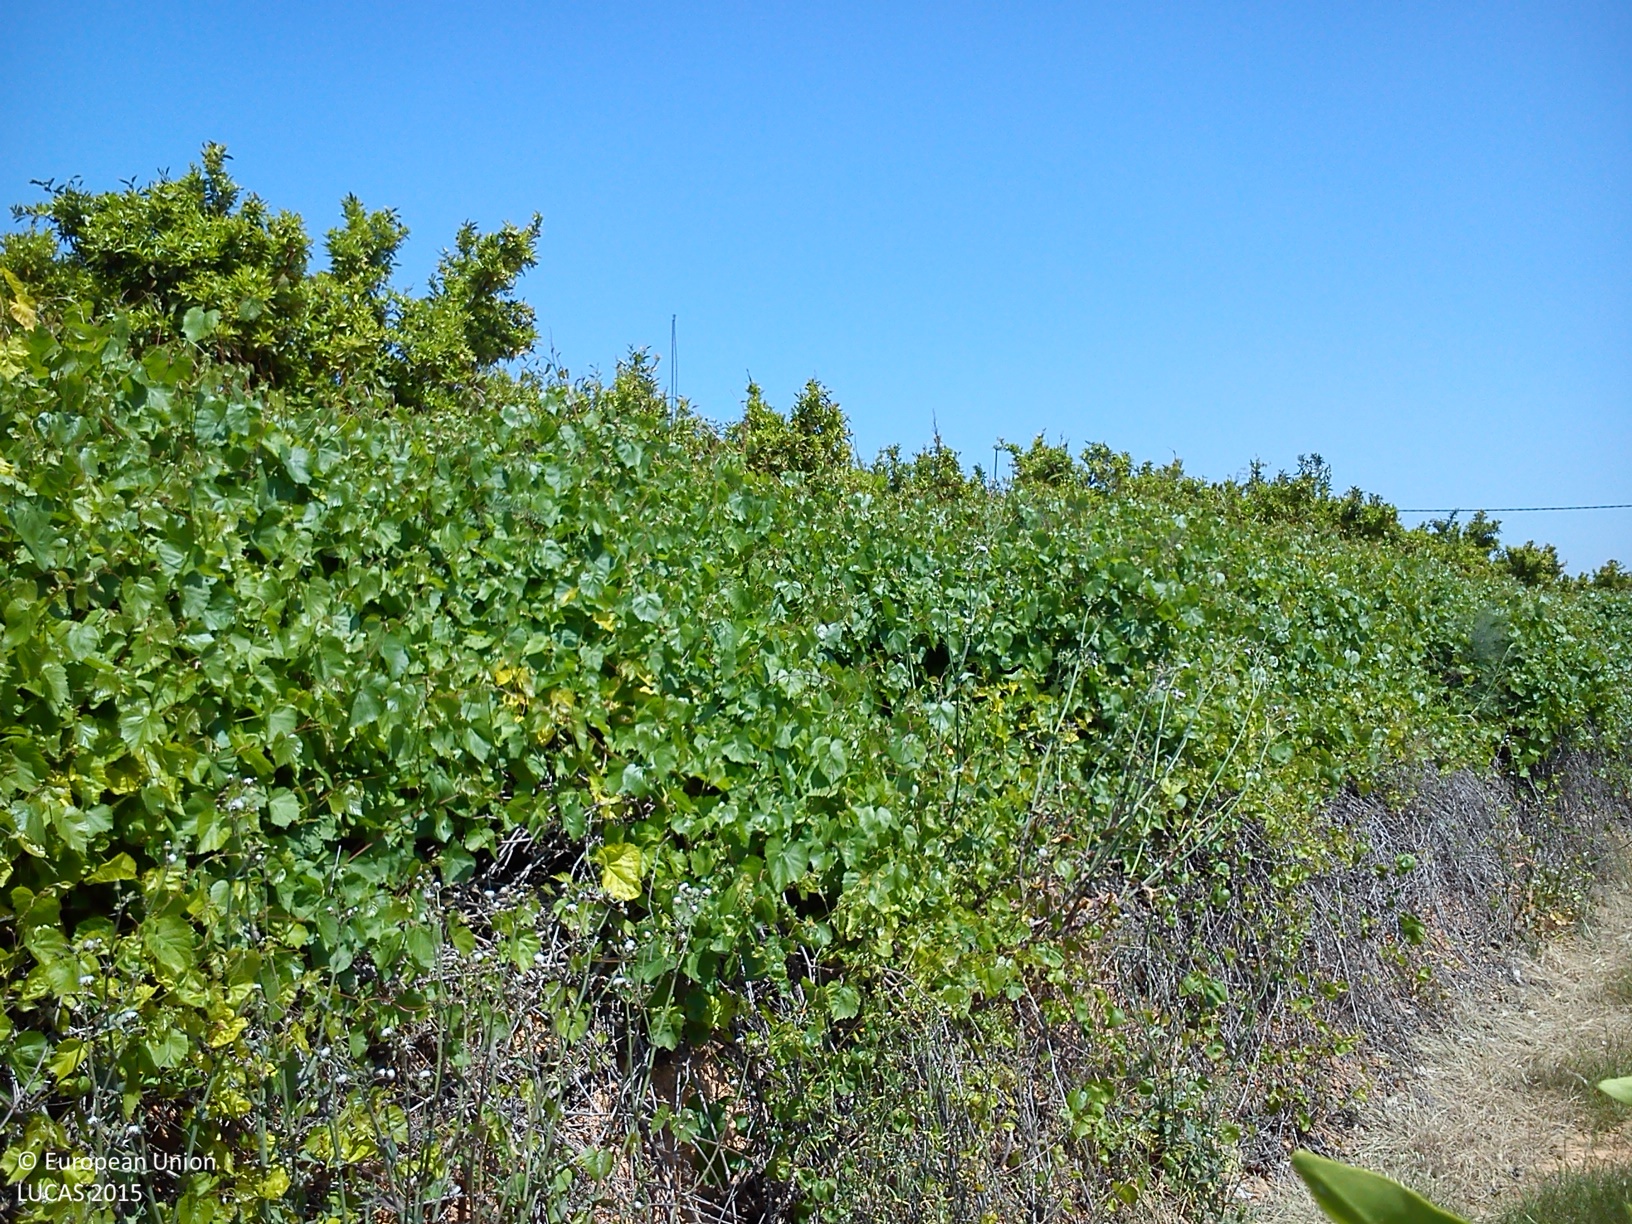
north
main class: Cropland
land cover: Oranges
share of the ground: 50 - 75 %
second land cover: Spontaneously vegetated surfaces
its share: < 10 %
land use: Agriculture (excluding fallow land and kitchen gardens)
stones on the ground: 10 - 25 %
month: April
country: ES
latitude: 39.6250
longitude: -0.7067
